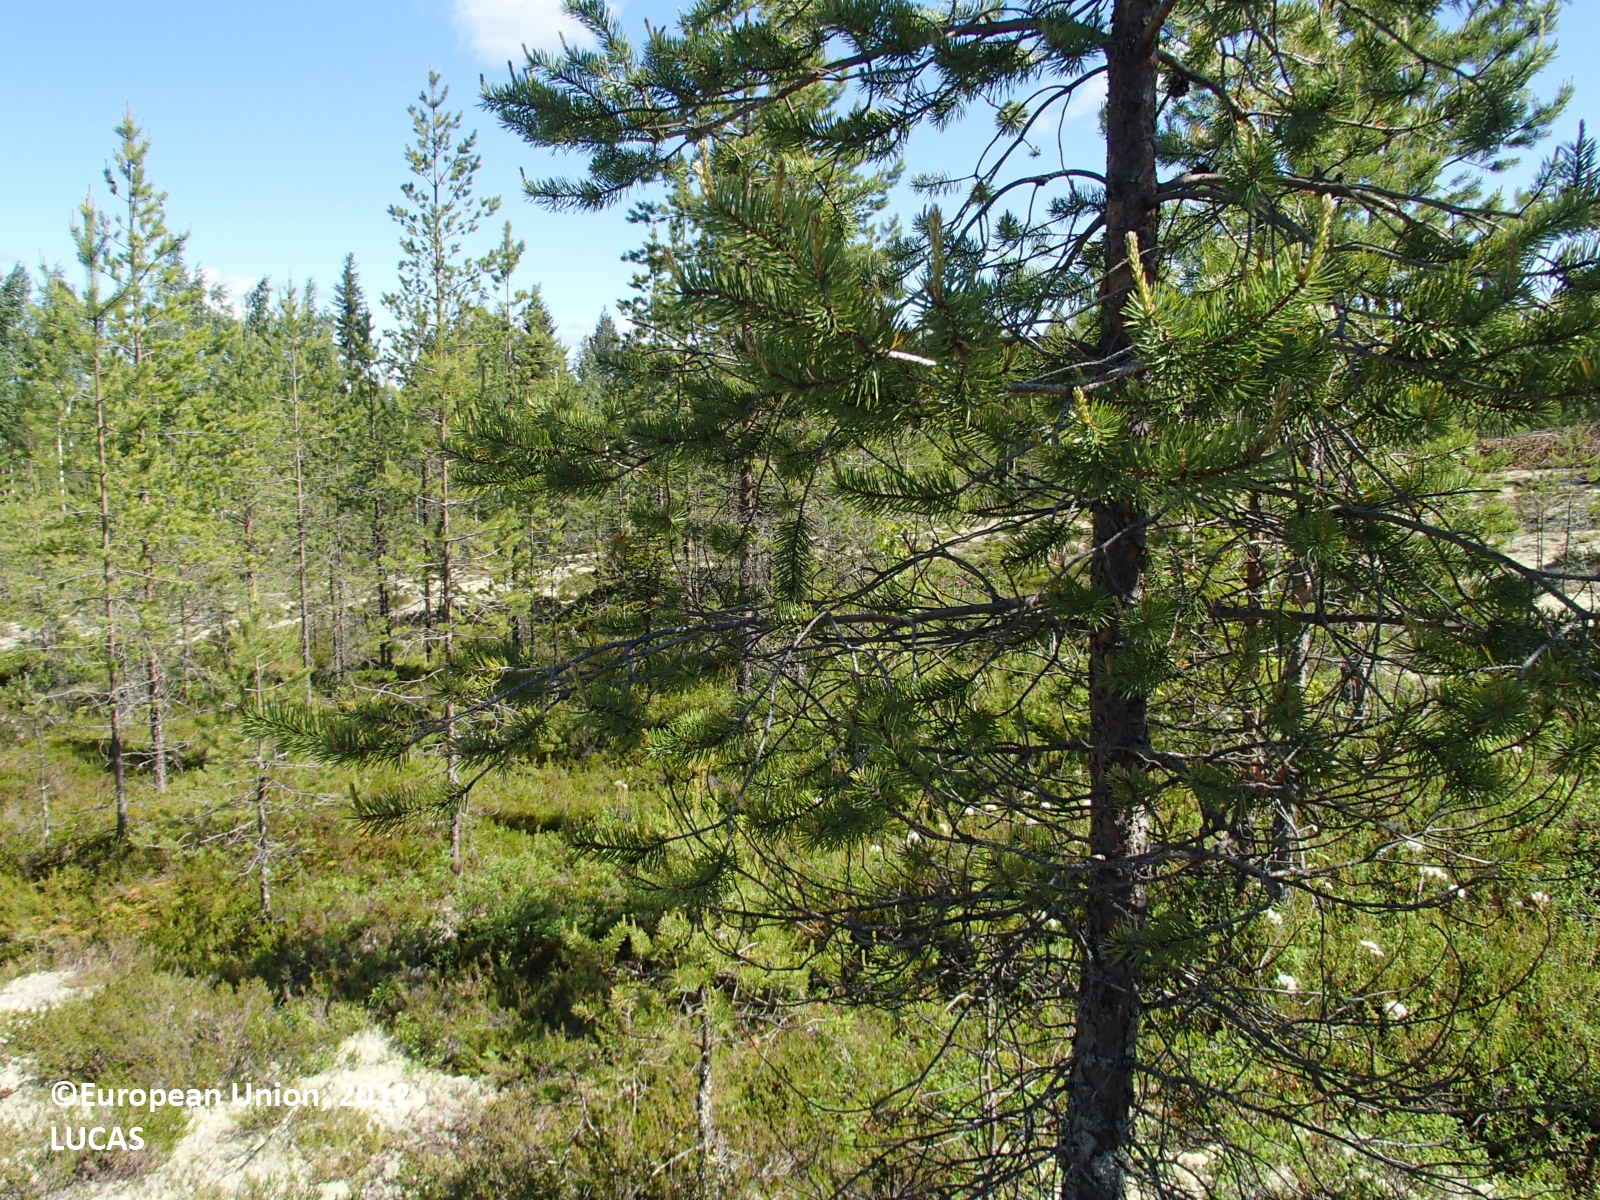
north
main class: Woodland
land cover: Pine dominated coniferous woodland
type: boreal forest
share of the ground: 25 - 50 %
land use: Forestry
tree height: < 5 m
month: June
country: FI
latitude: 64.2077
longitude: 27.3847
